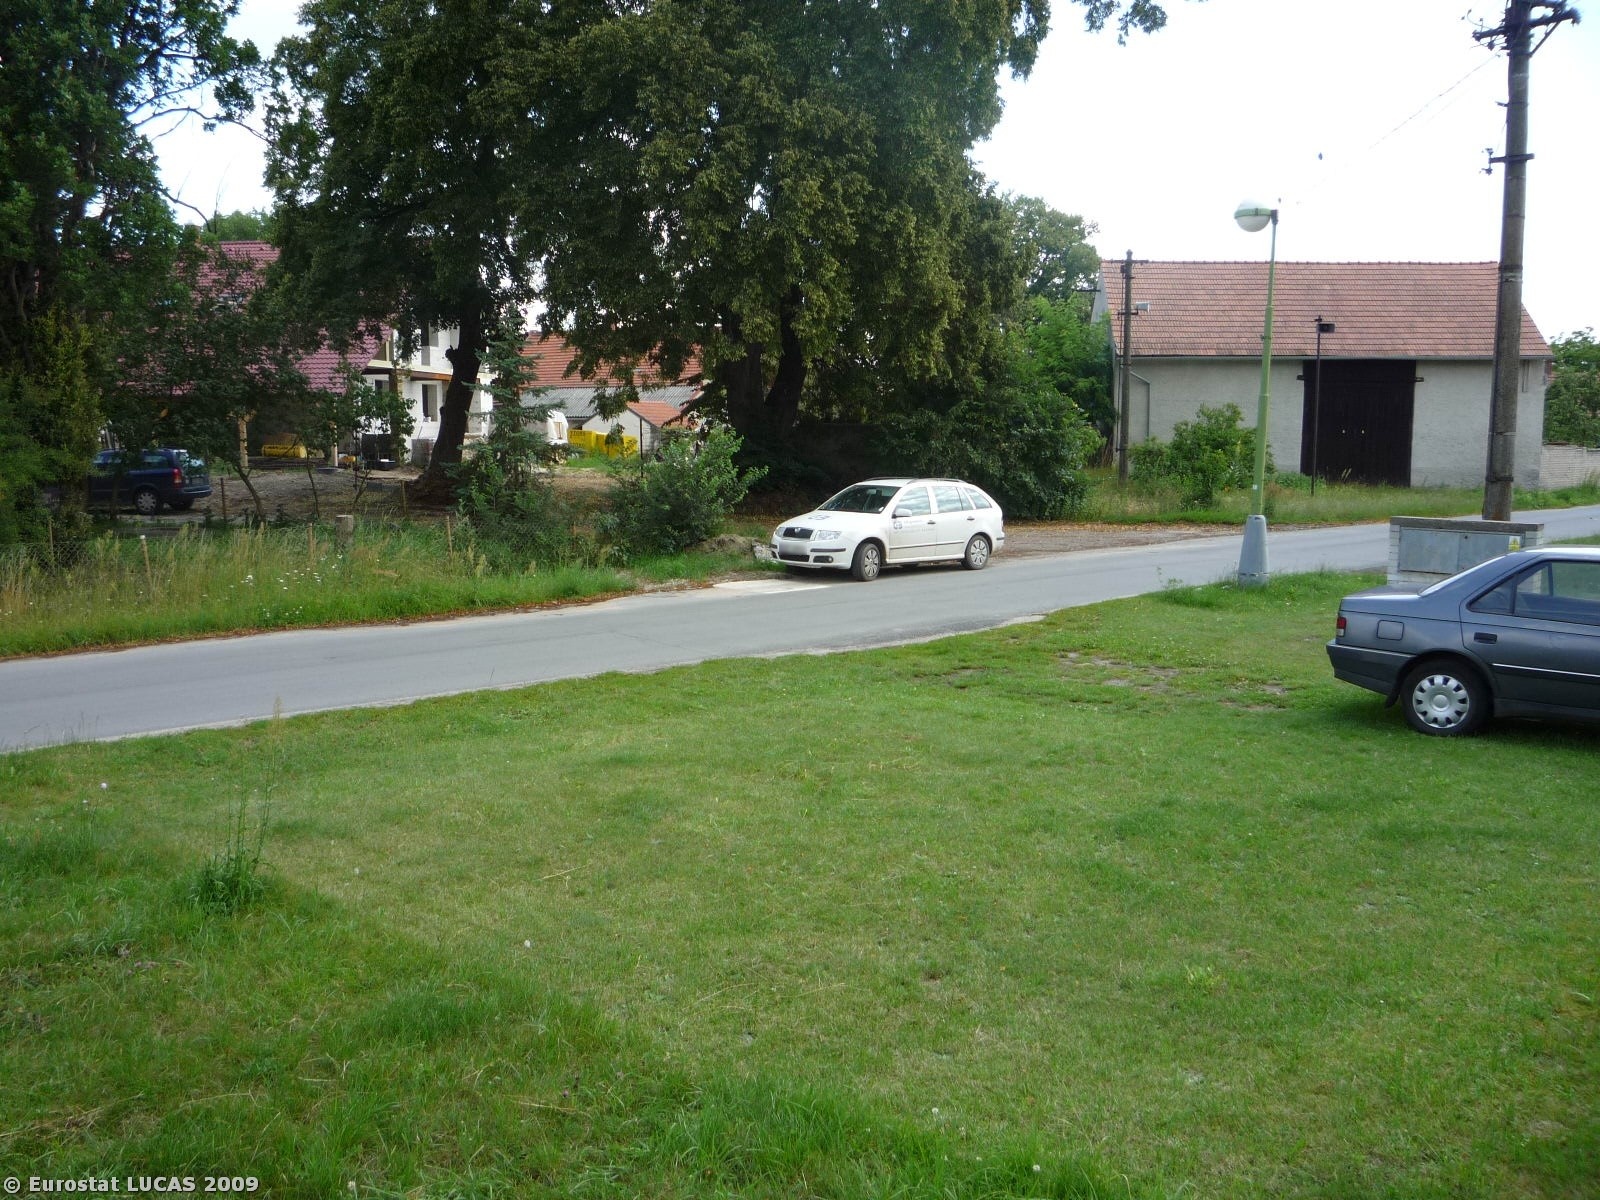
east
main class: Cropland
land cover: Pear fruit
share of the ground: 25 - 50 %
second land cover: Grassland with sparse tree/shrub cover
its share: > 75 %
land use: Kitchen garden
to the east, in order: Pear fruit; Grassland with sparse tree/shrub cover; Artificial constructions in urban areas
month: July
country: CZ
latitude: 50.1647
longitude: 15.0005
